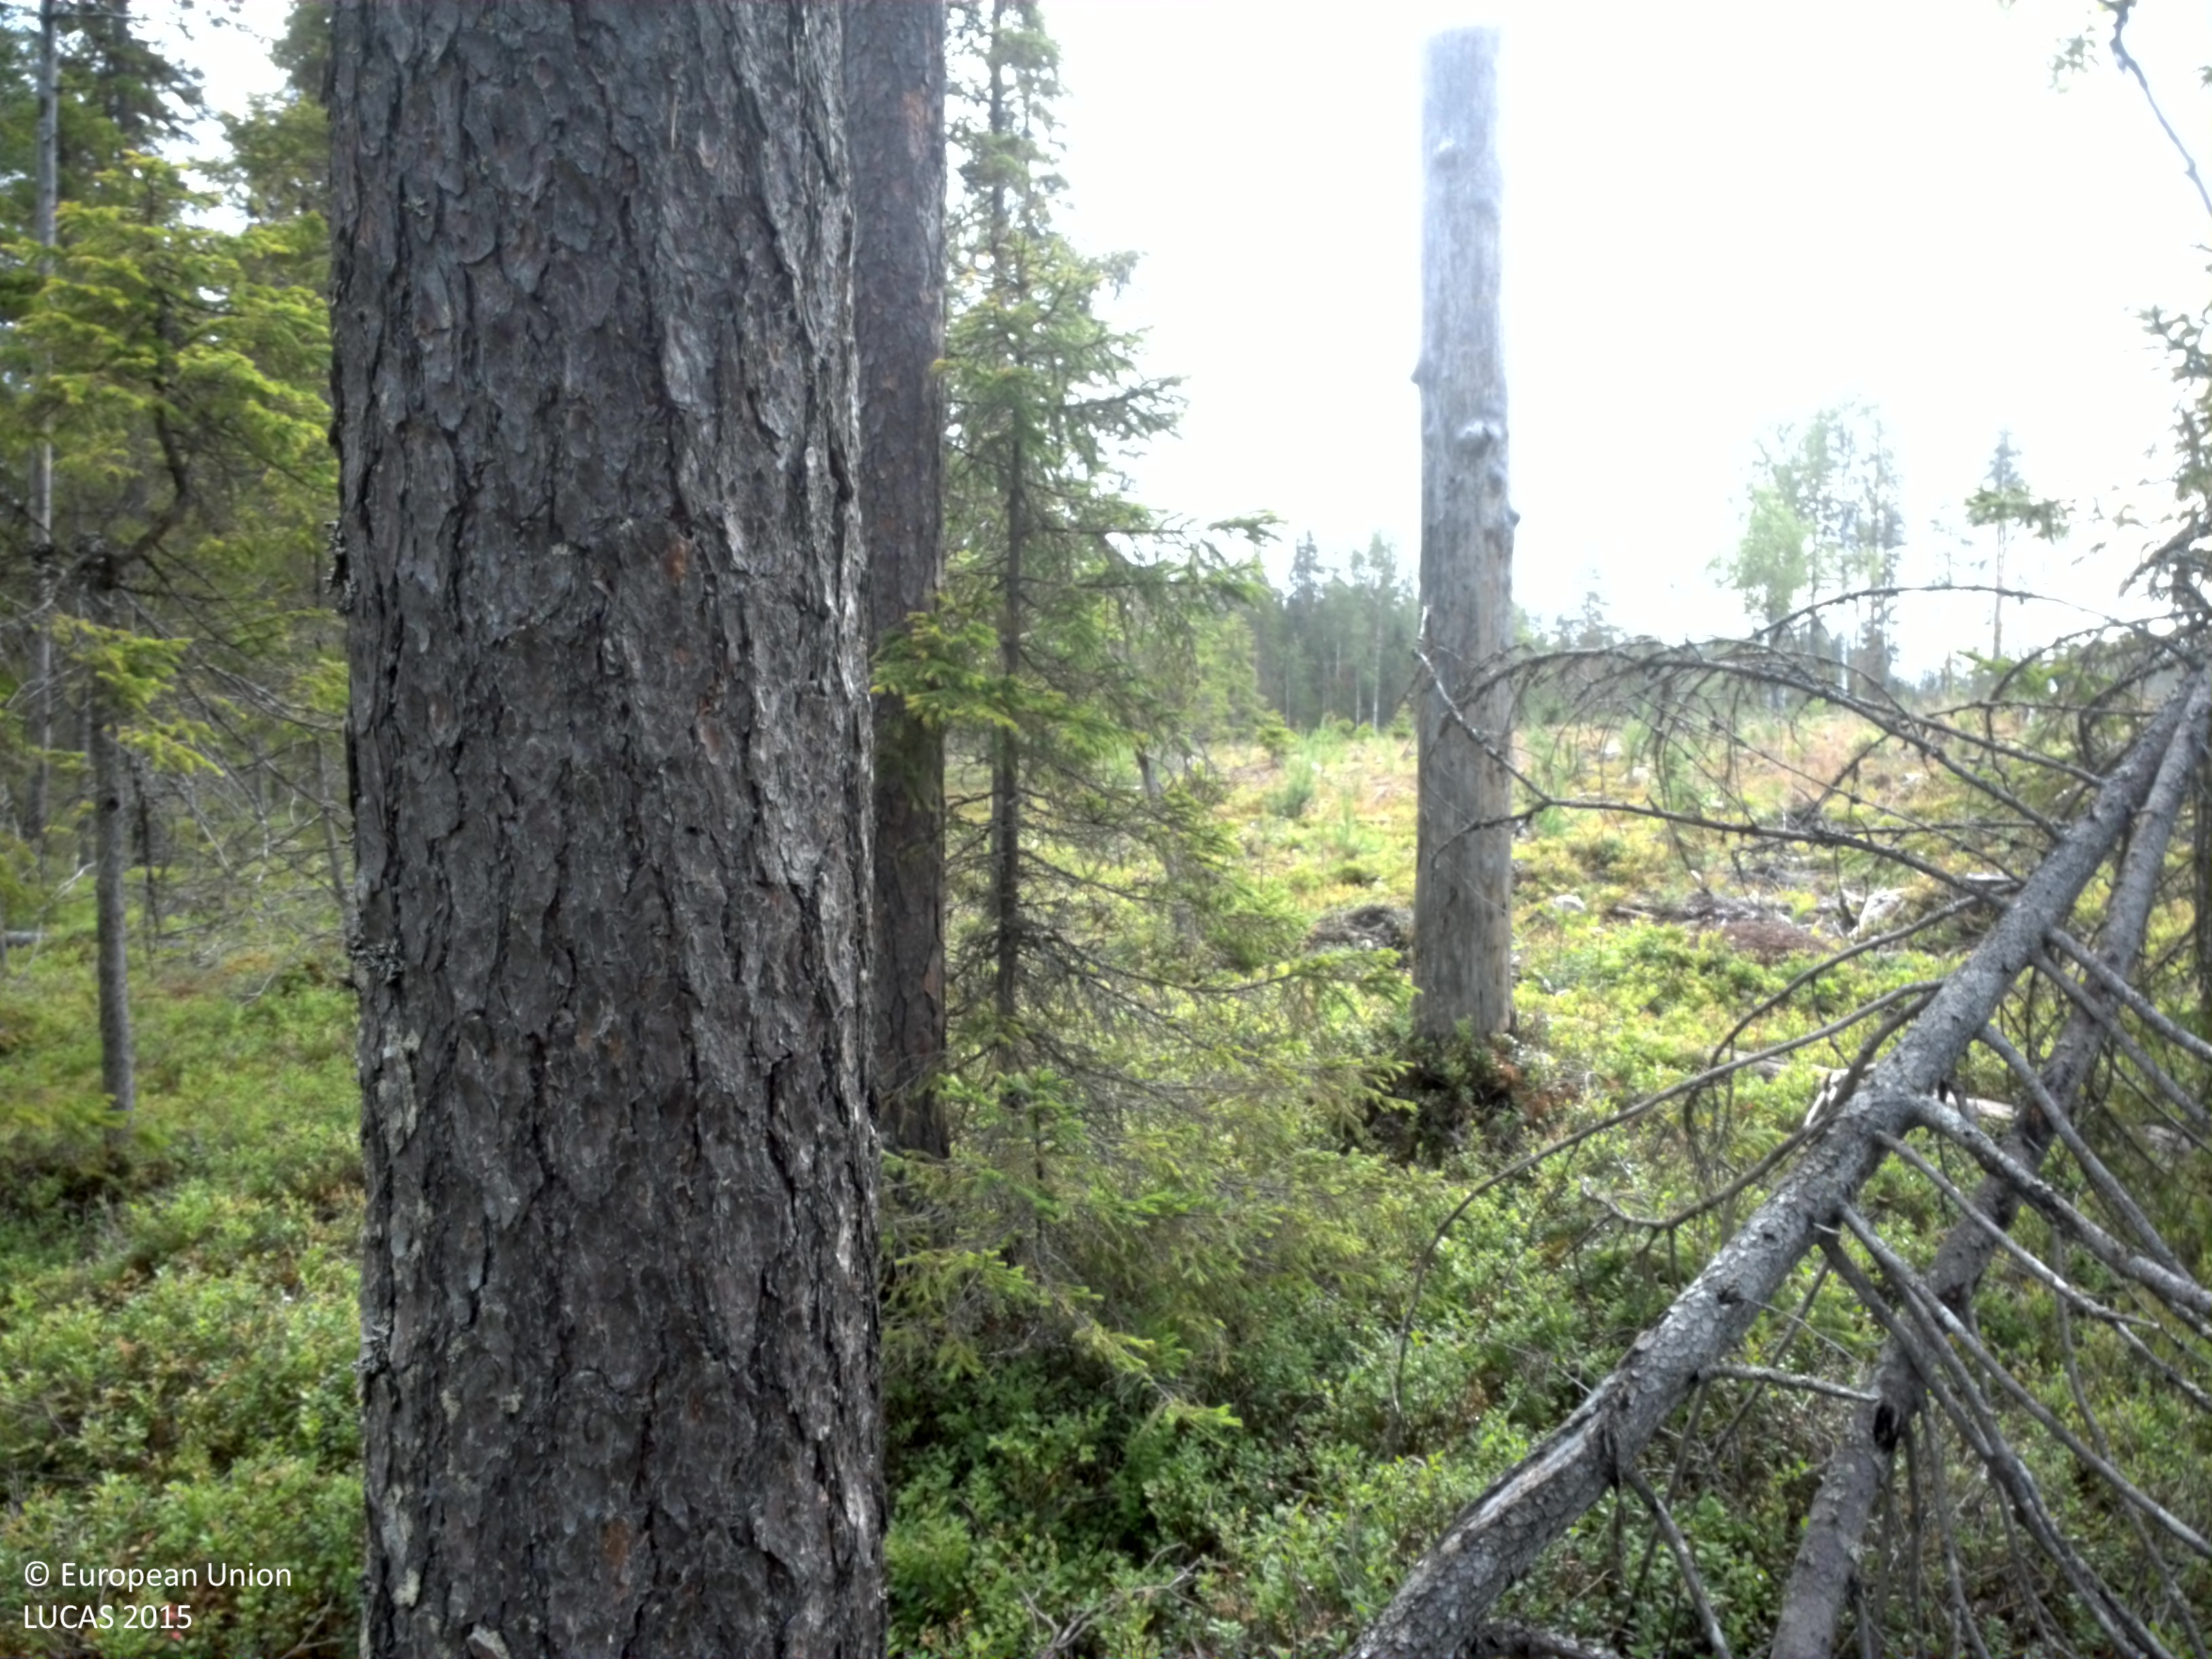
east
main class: Woodland
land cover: Pine dominated coniferous woodland
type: boreal forest
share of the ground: 50 - 75 %
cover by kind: coniferous forest trees 60 %, shrubs 35 %, lichens and mosses 5 %
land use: Forestry
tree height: > 5 m
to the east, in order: Pine dominated coniferous woodland; Shrubland without tree cover; Spruce dominated coniferous woodland; Pine dominated coniferous woodland; Pine dominated mixed woodland
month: August
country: SE
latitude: 64.7510
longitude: 20.3745
